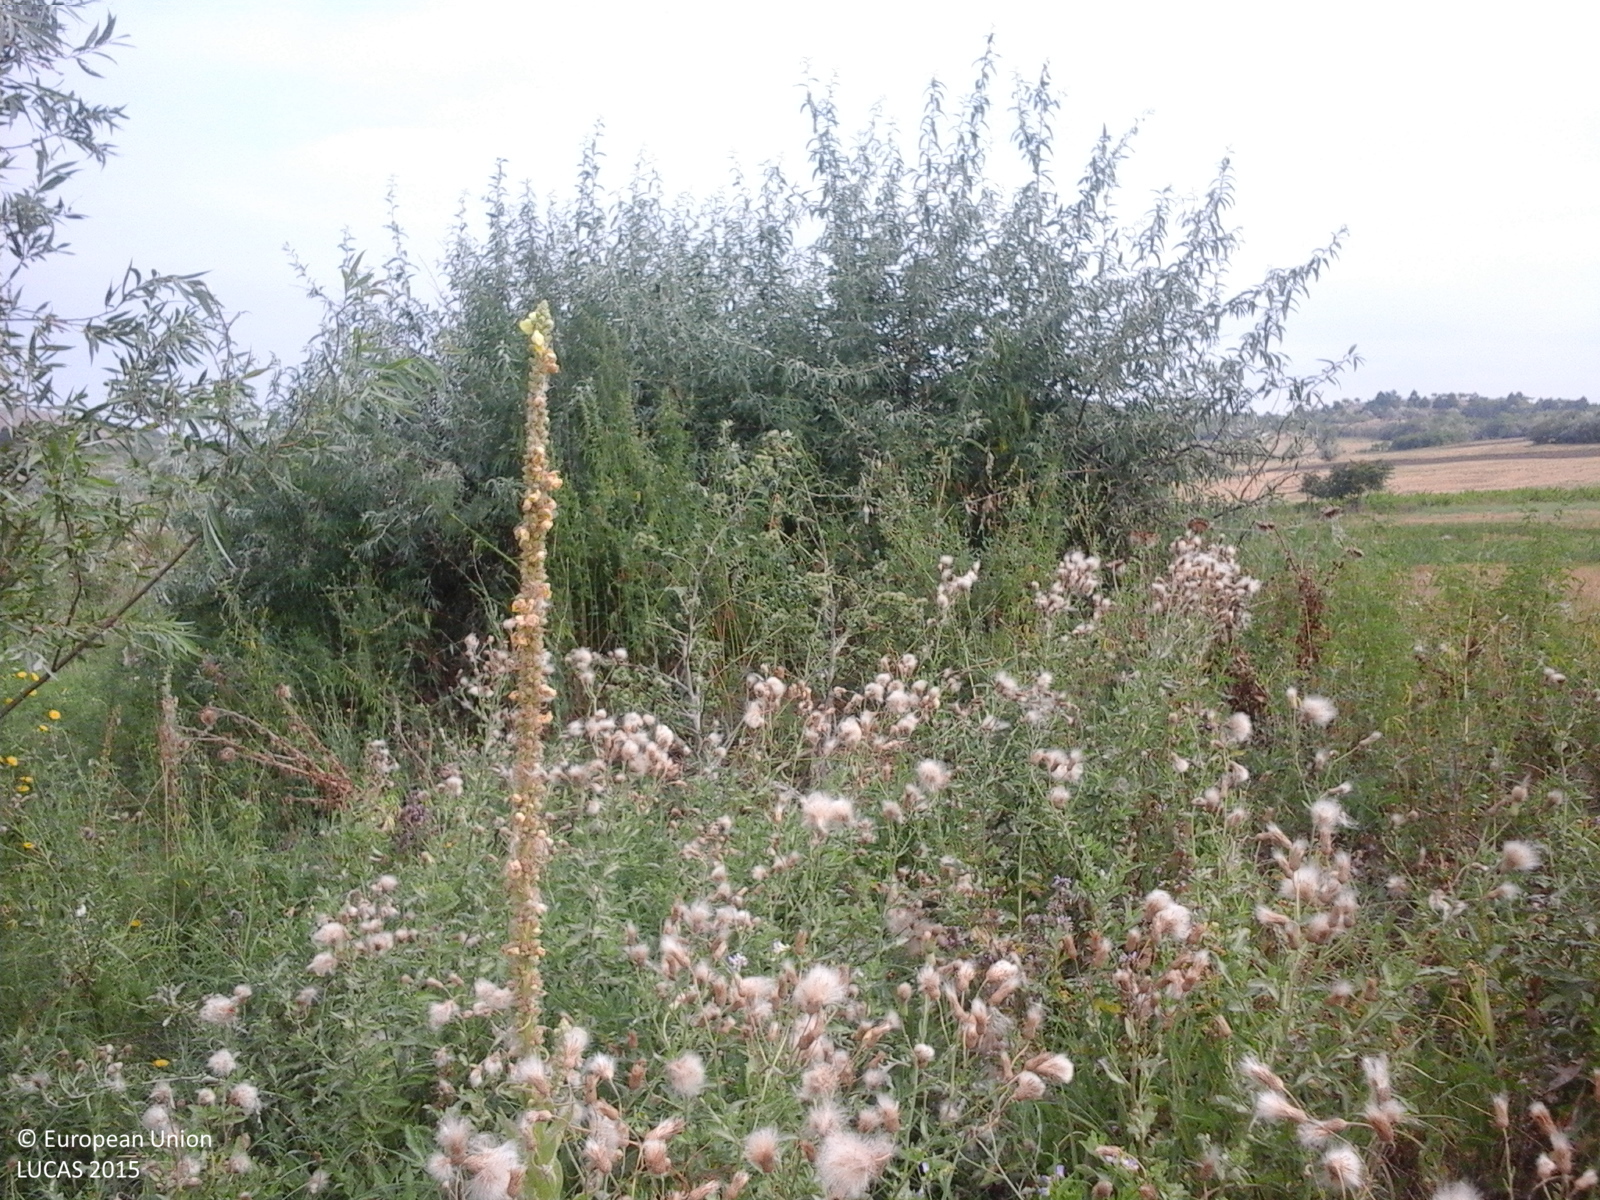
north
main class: Cropland
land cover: Maize
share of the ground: > 75 %
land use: Agriculture (excluding fallow land and kitchen gardens)
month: July
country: RO
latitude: 45.3781
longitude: 28.1132
